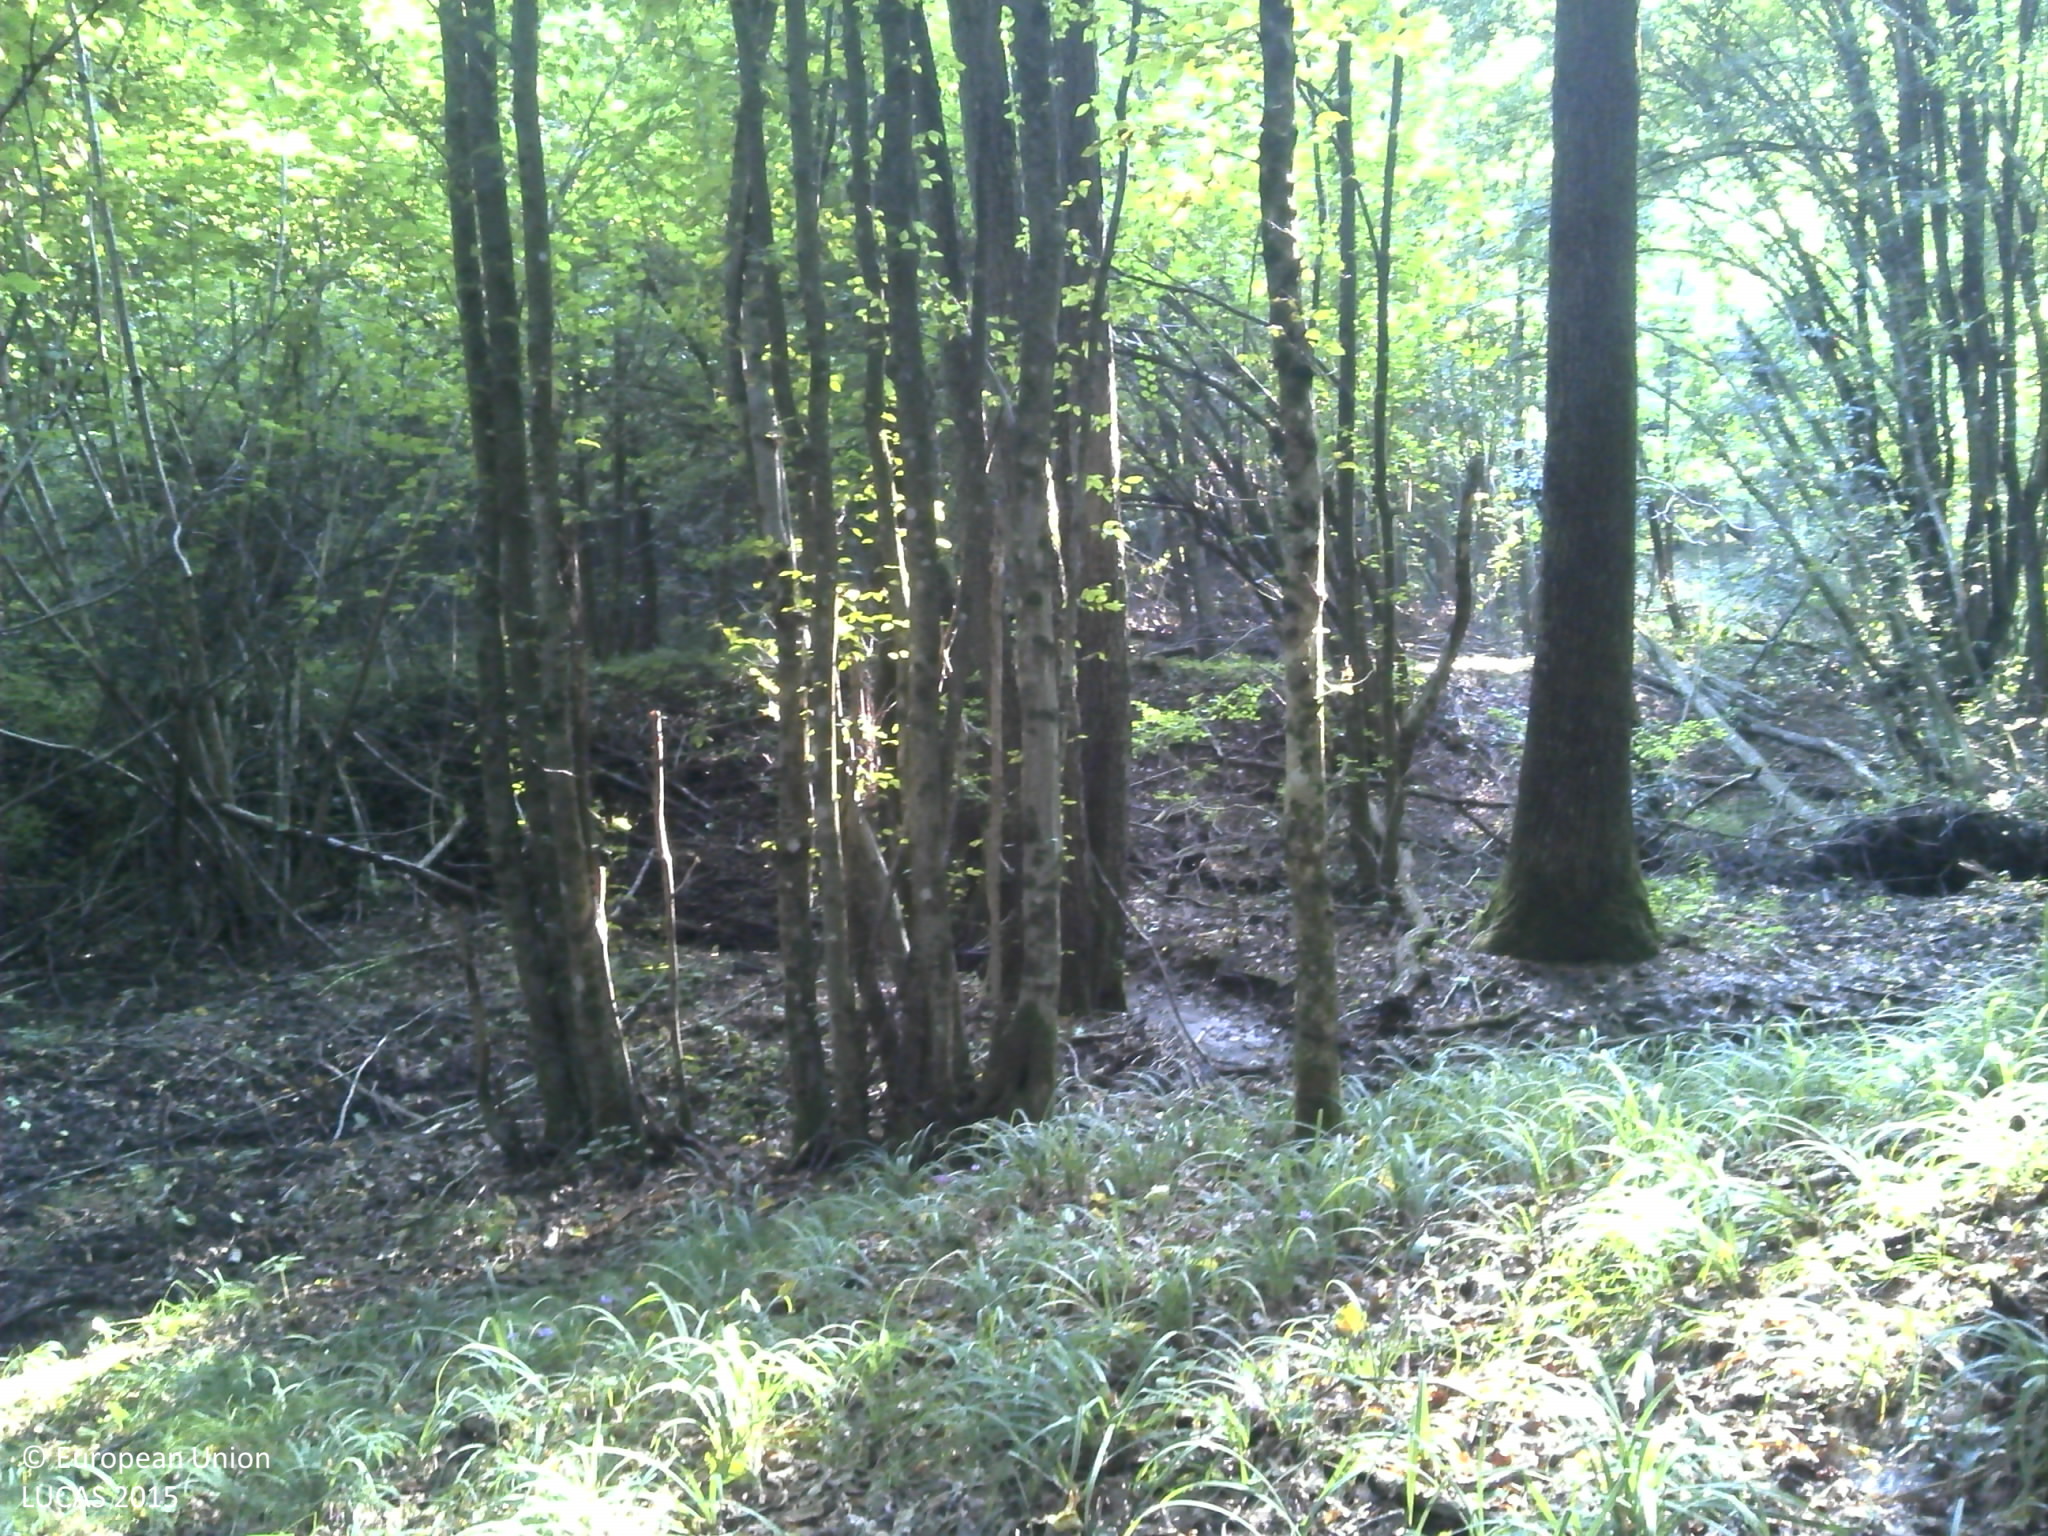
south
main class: Woodland
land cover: Broadleaved woodland
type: beech forest
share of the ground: > 75 %
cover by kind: broadleaved forest trees 100 %
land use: Forestry
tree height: > 5 m
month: August
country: HR
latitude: 45.2641
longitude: 16.5610
